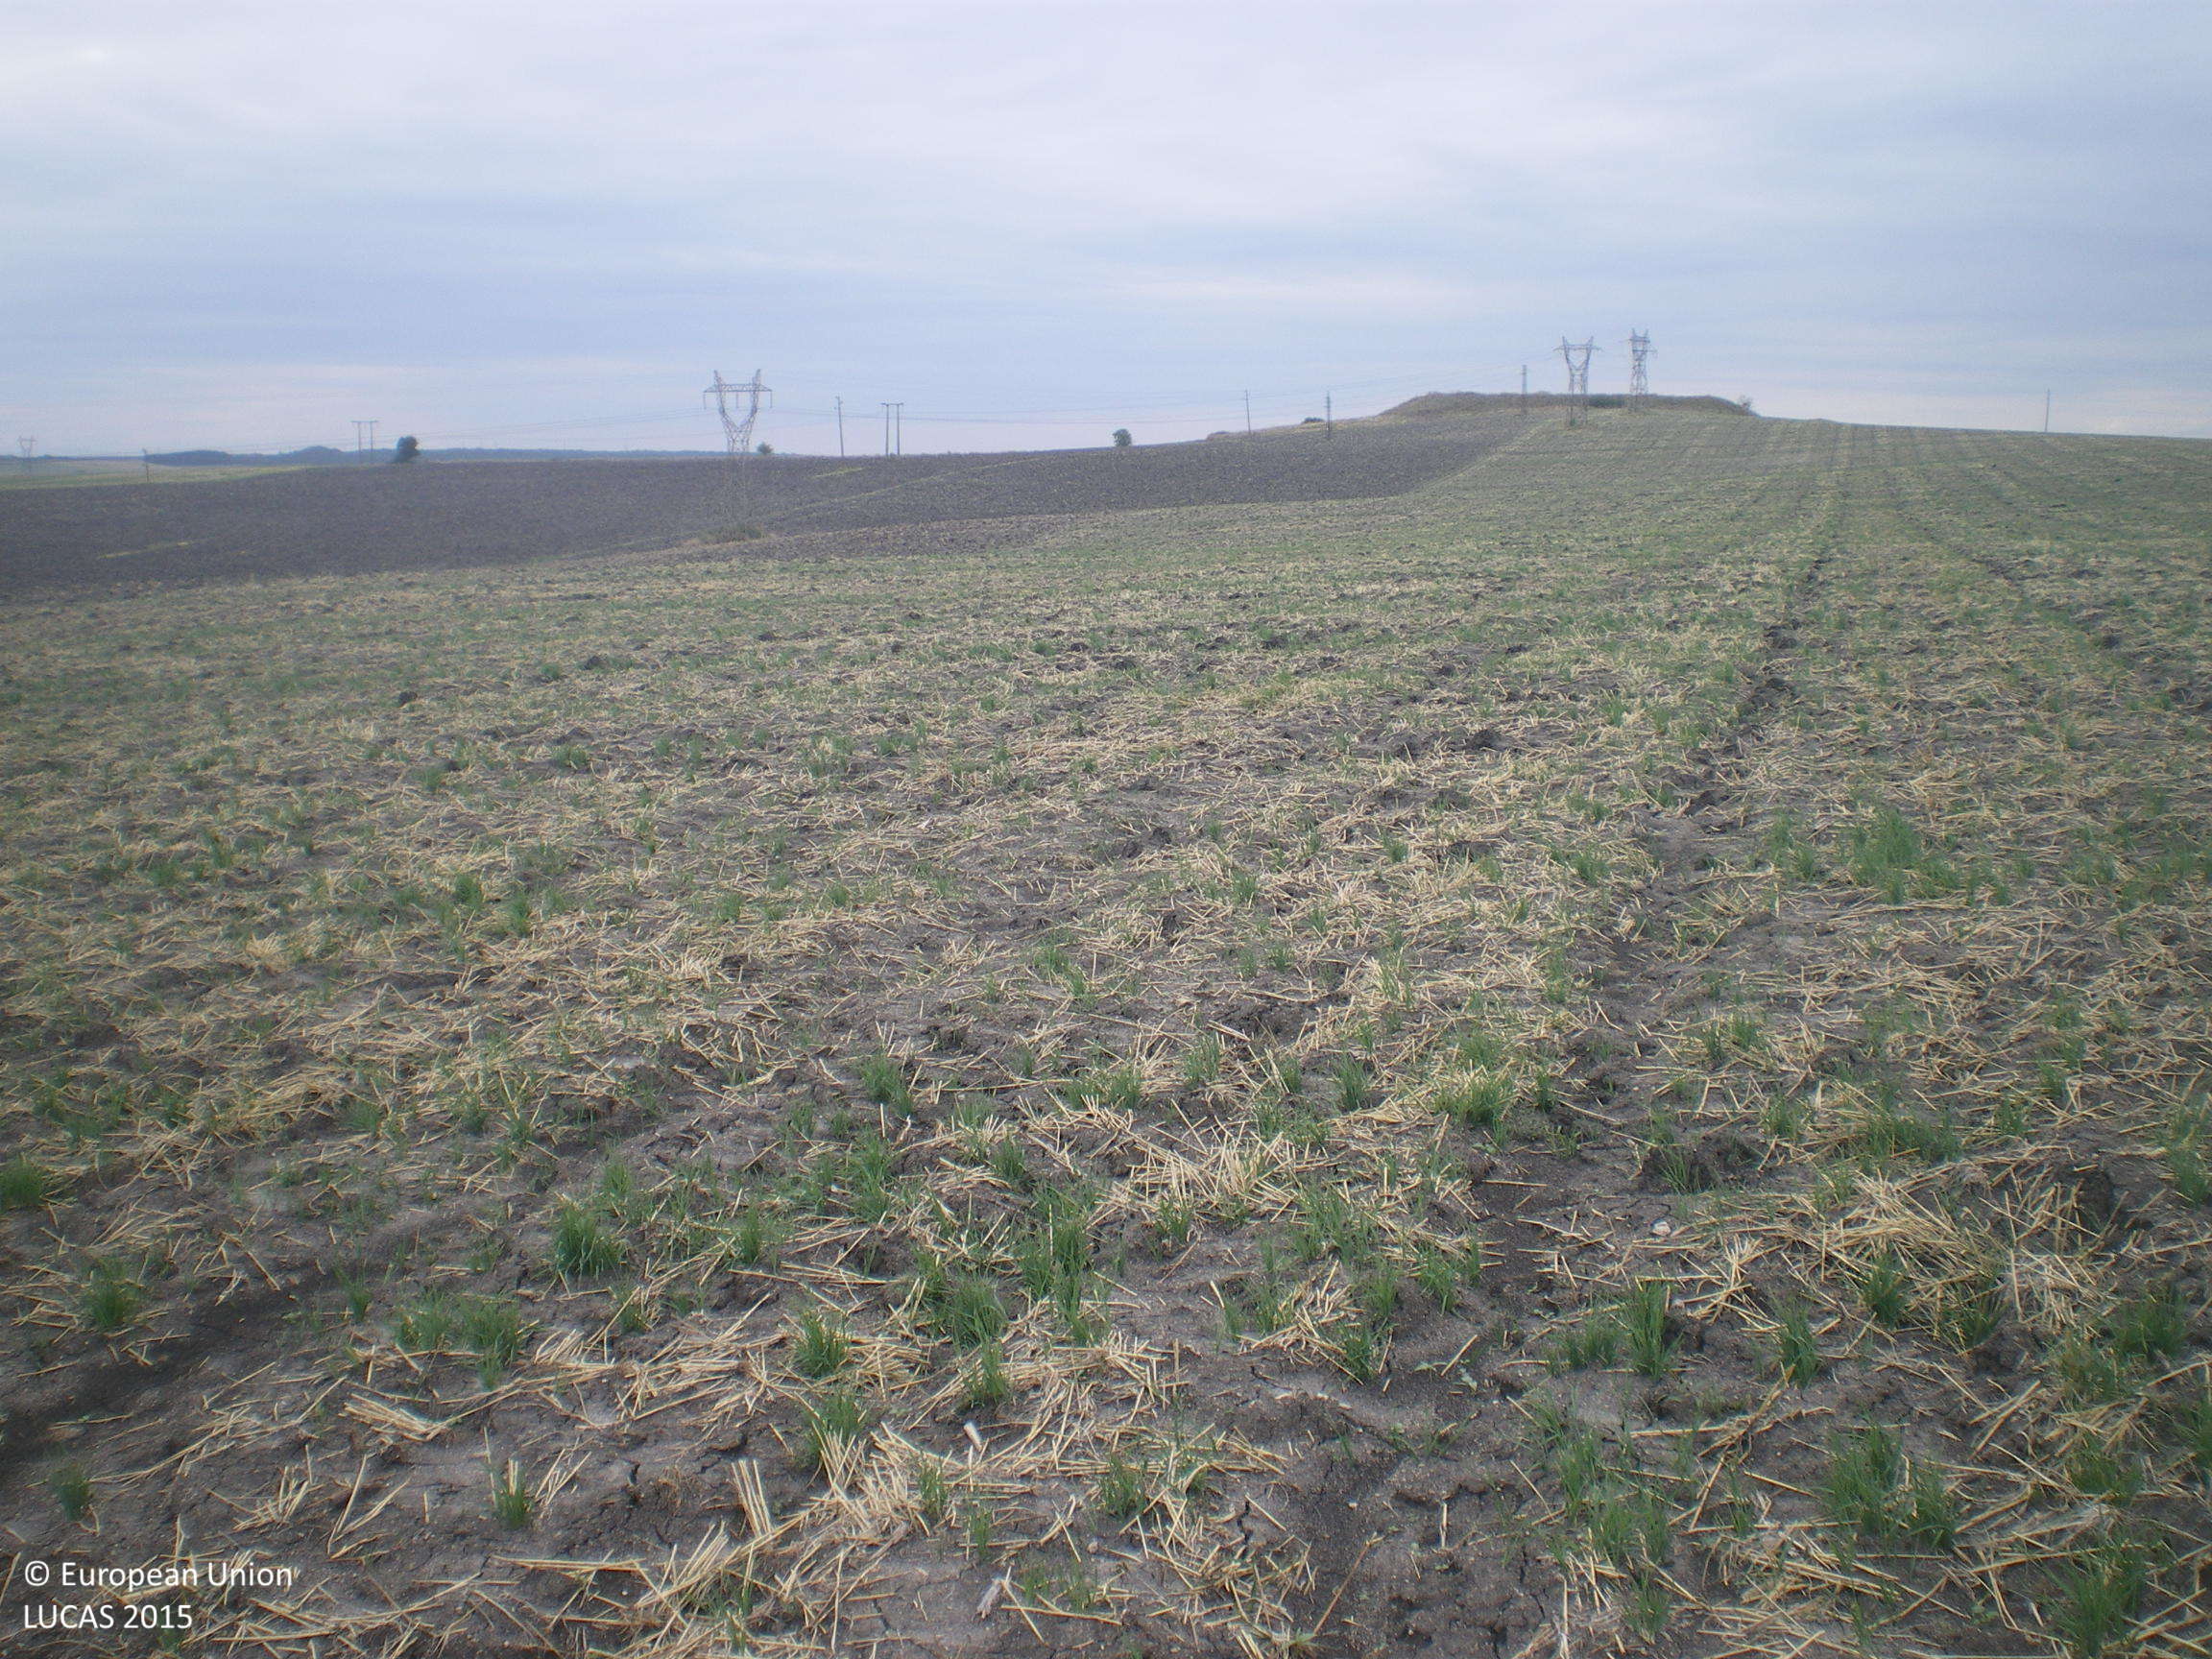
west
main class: Cropland
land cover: Common wheat
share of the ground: < 10 %
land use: Agriculture (excluding fallow land and kitchen gardens)
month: September
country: BG
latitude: 42.1965
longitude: 25.9028
